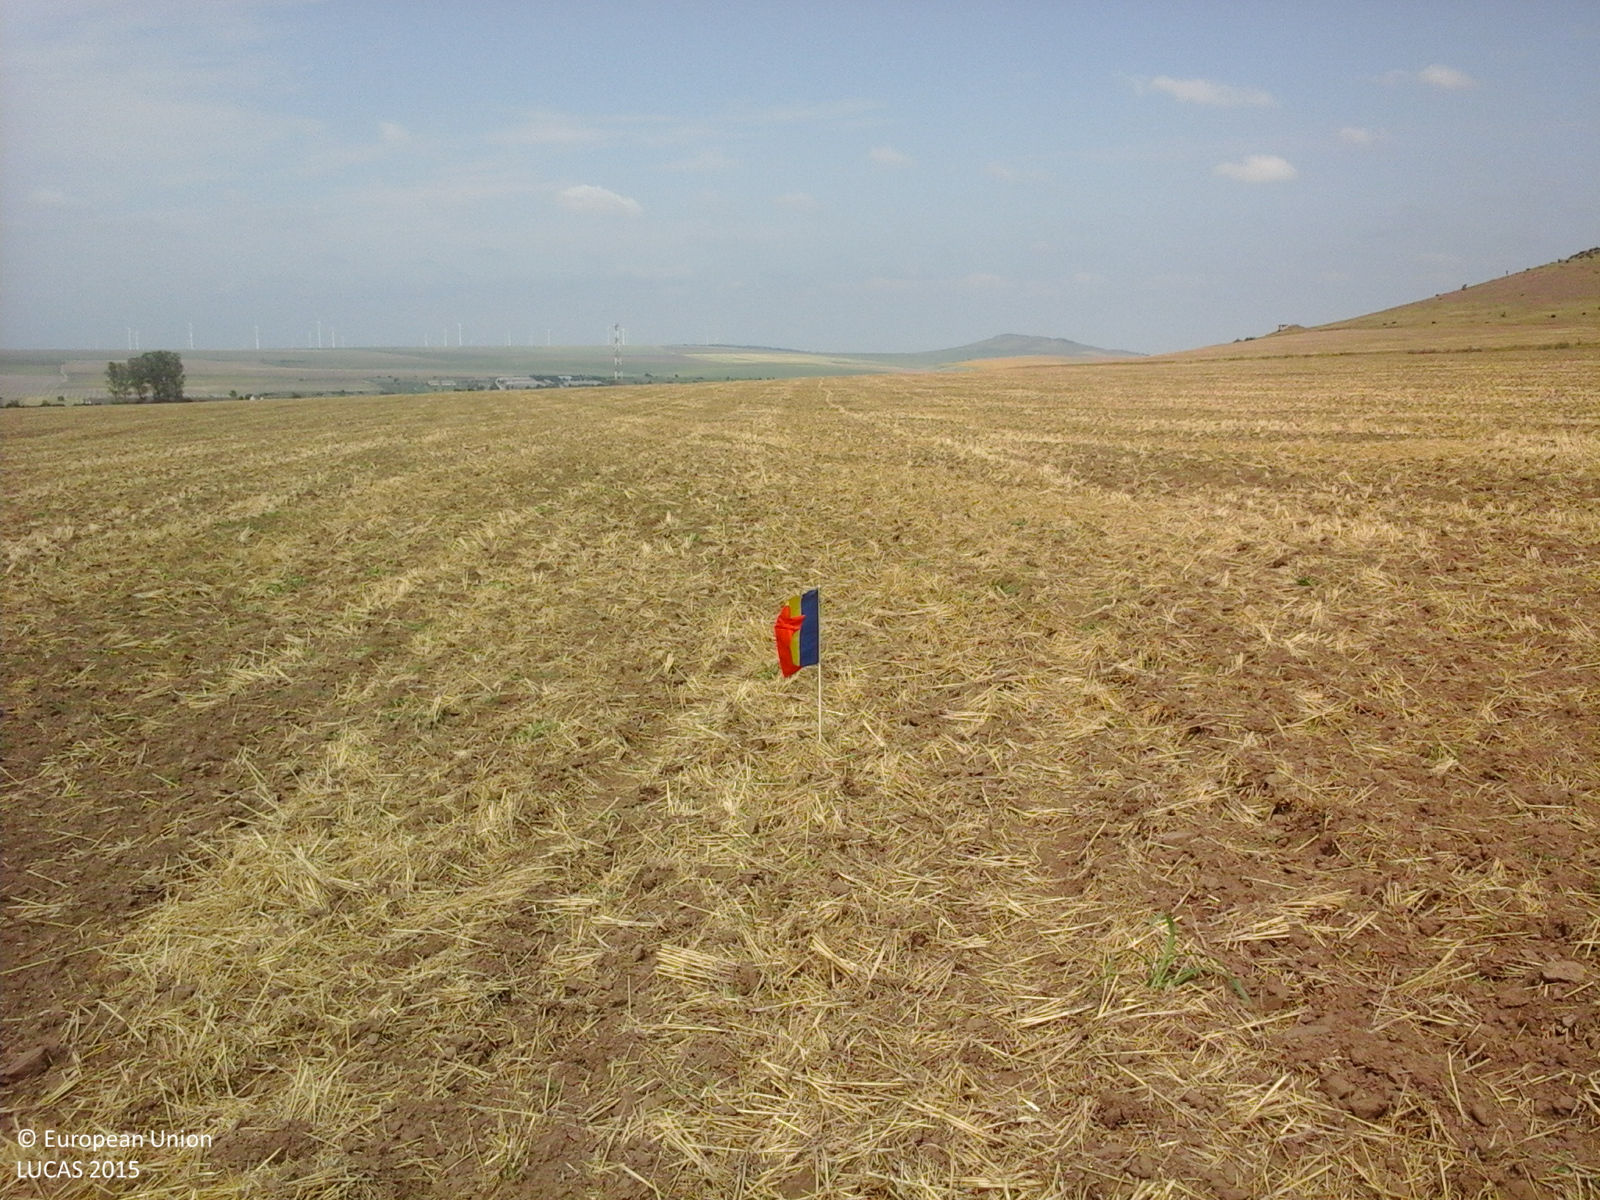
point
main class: Cropland
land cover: Common wheat
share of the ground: 25 - 50 %
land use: Agriculture (excluding fallow land and kitchen gardens)
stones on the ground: < 10 %
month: August
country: RO
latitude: 45.0825
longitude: 29.0392
